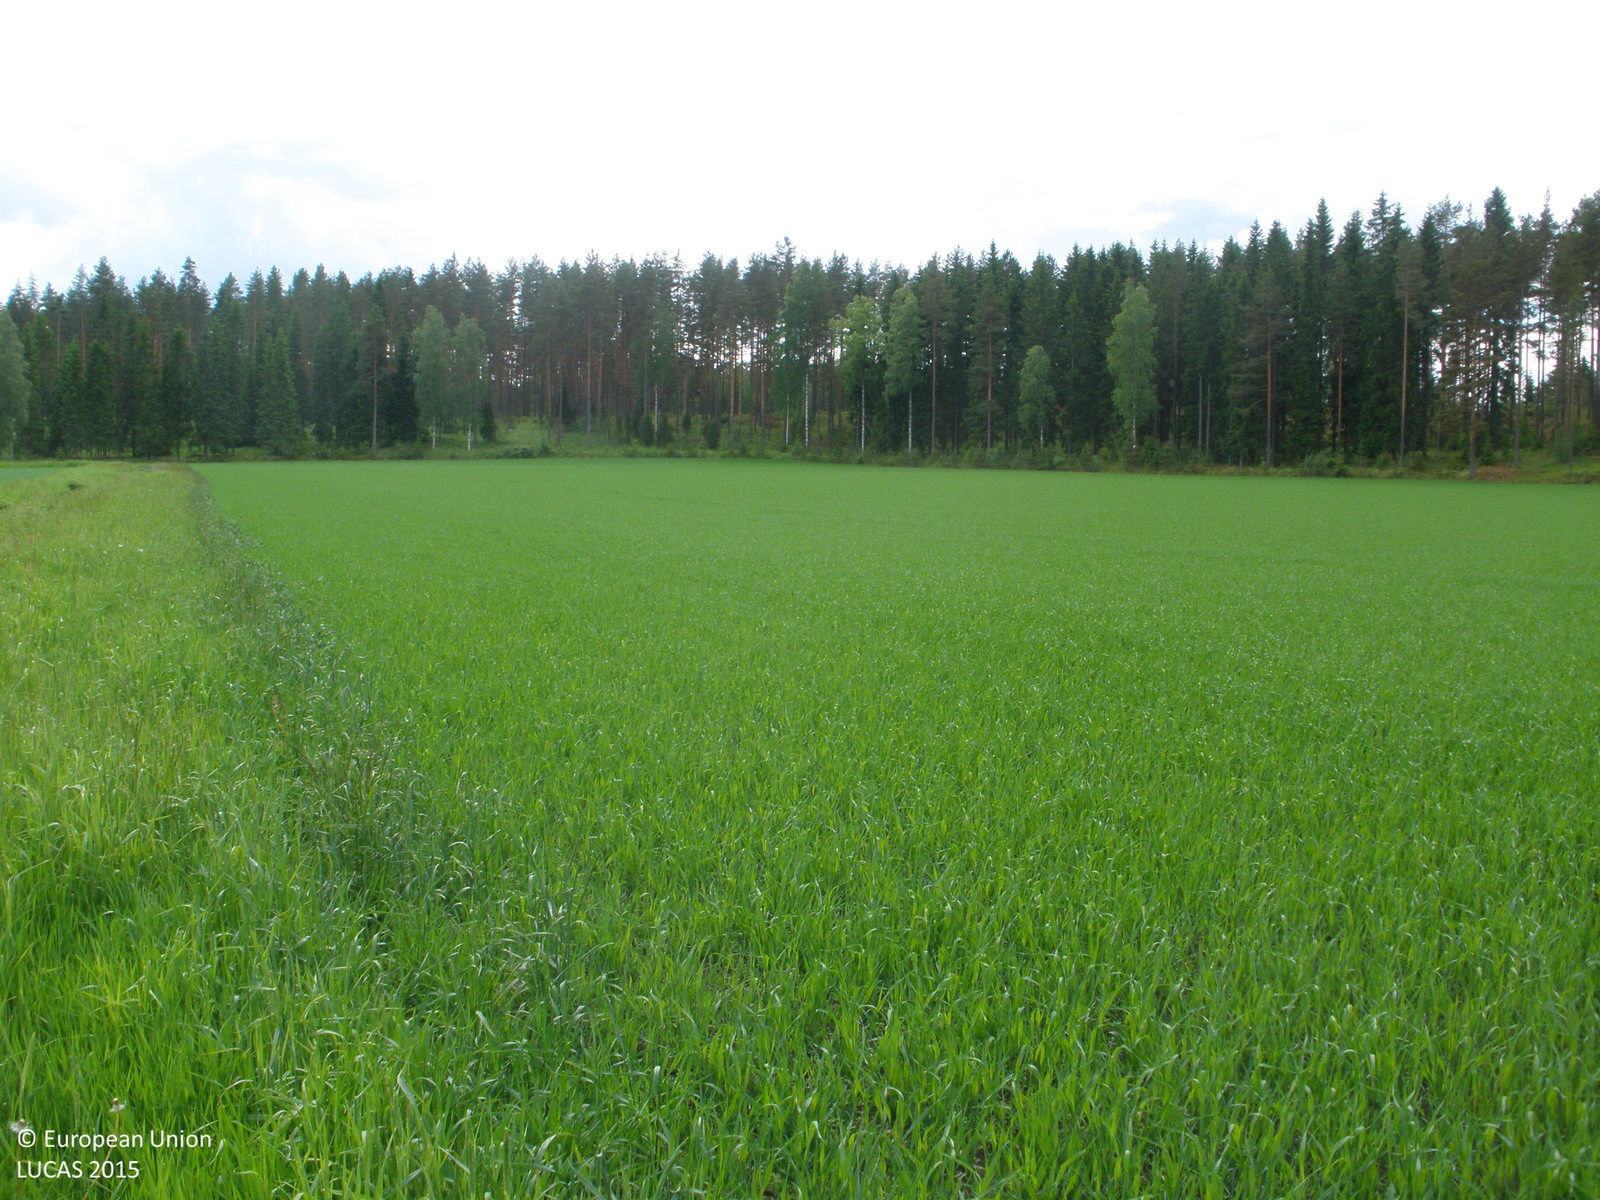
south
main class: Cropland
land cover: Oats
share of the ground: > 75 %
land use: Agriculture (excluding fallow land and kitchen gardens)
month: June
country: FI
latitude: 61.0318
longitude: 23.2762
